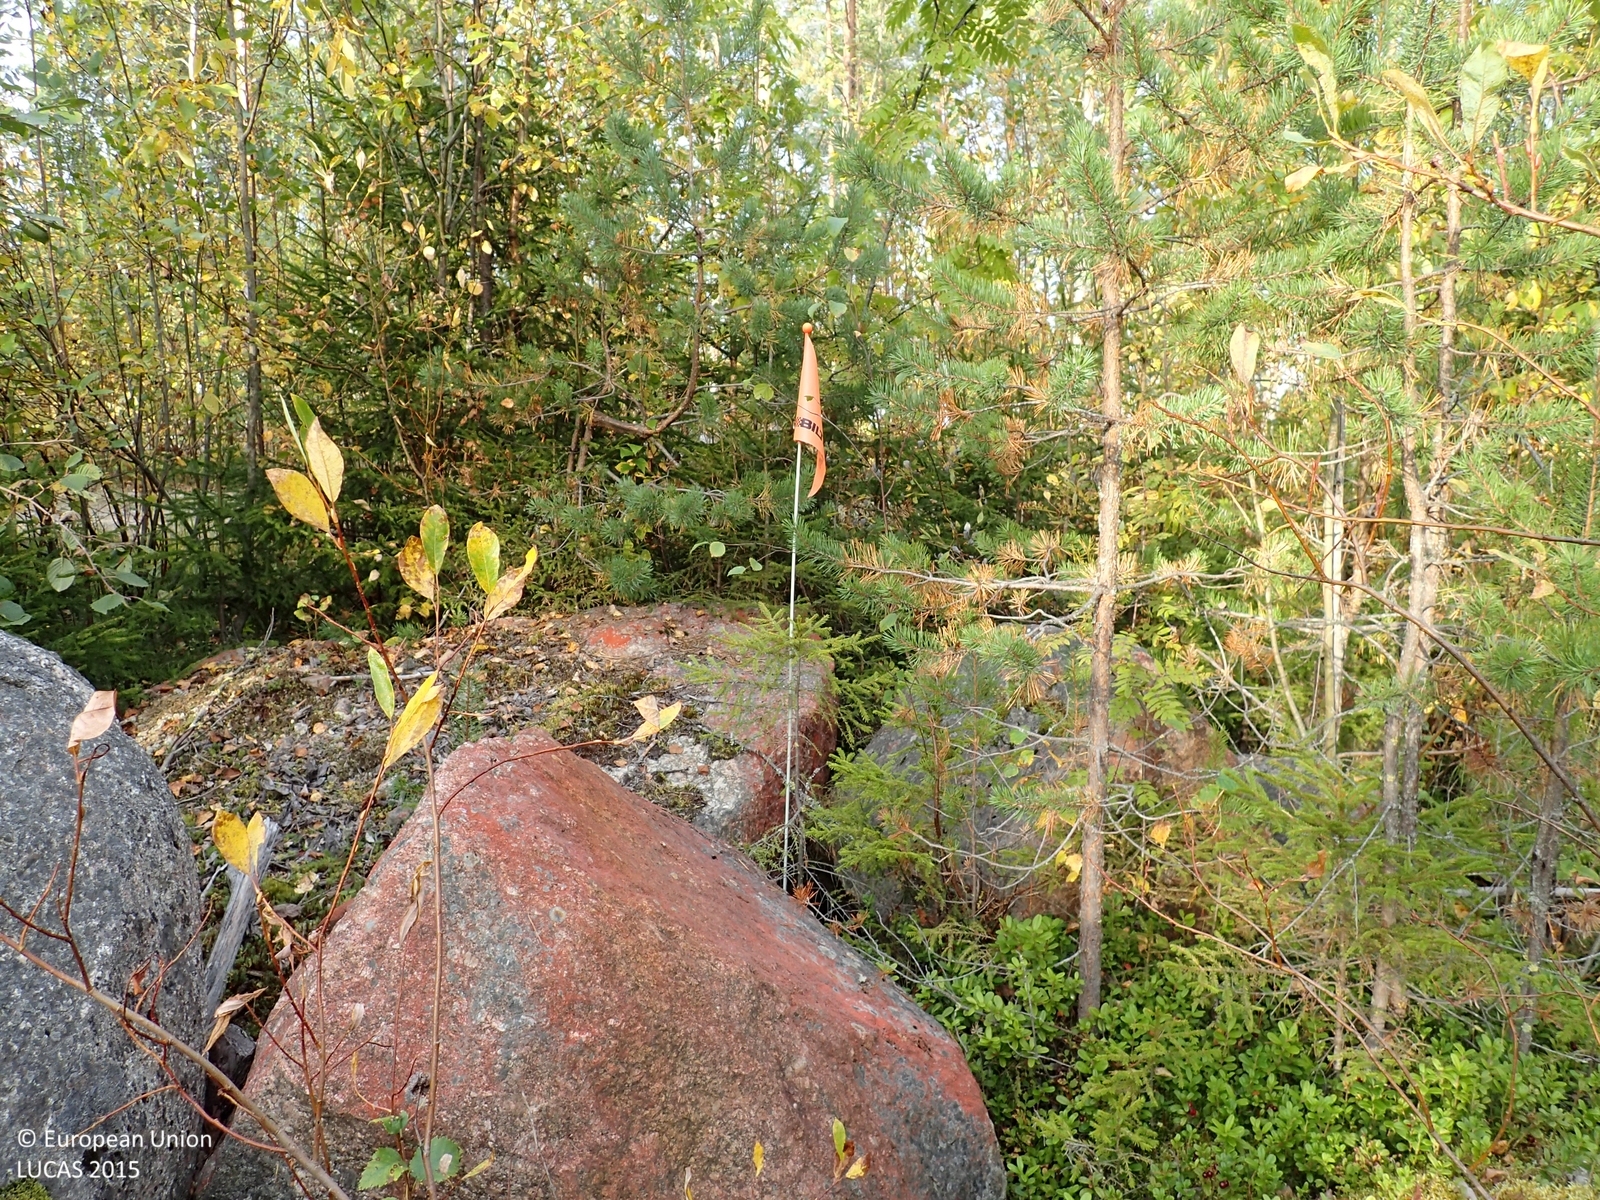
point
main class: Woodland
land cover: Pine dominated mixed woodland
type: boreal forest
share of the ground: 50 - 75 %
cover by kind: shrubs 40 %, broadleaved forest trees 35 %, coniferous forest trees 15 %, lichens and mosses 5 %, consolidated bare surface 5 %
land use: Forestry
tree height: < 5 m
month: September
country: FI
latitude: 63.0316
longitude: 25.7464
